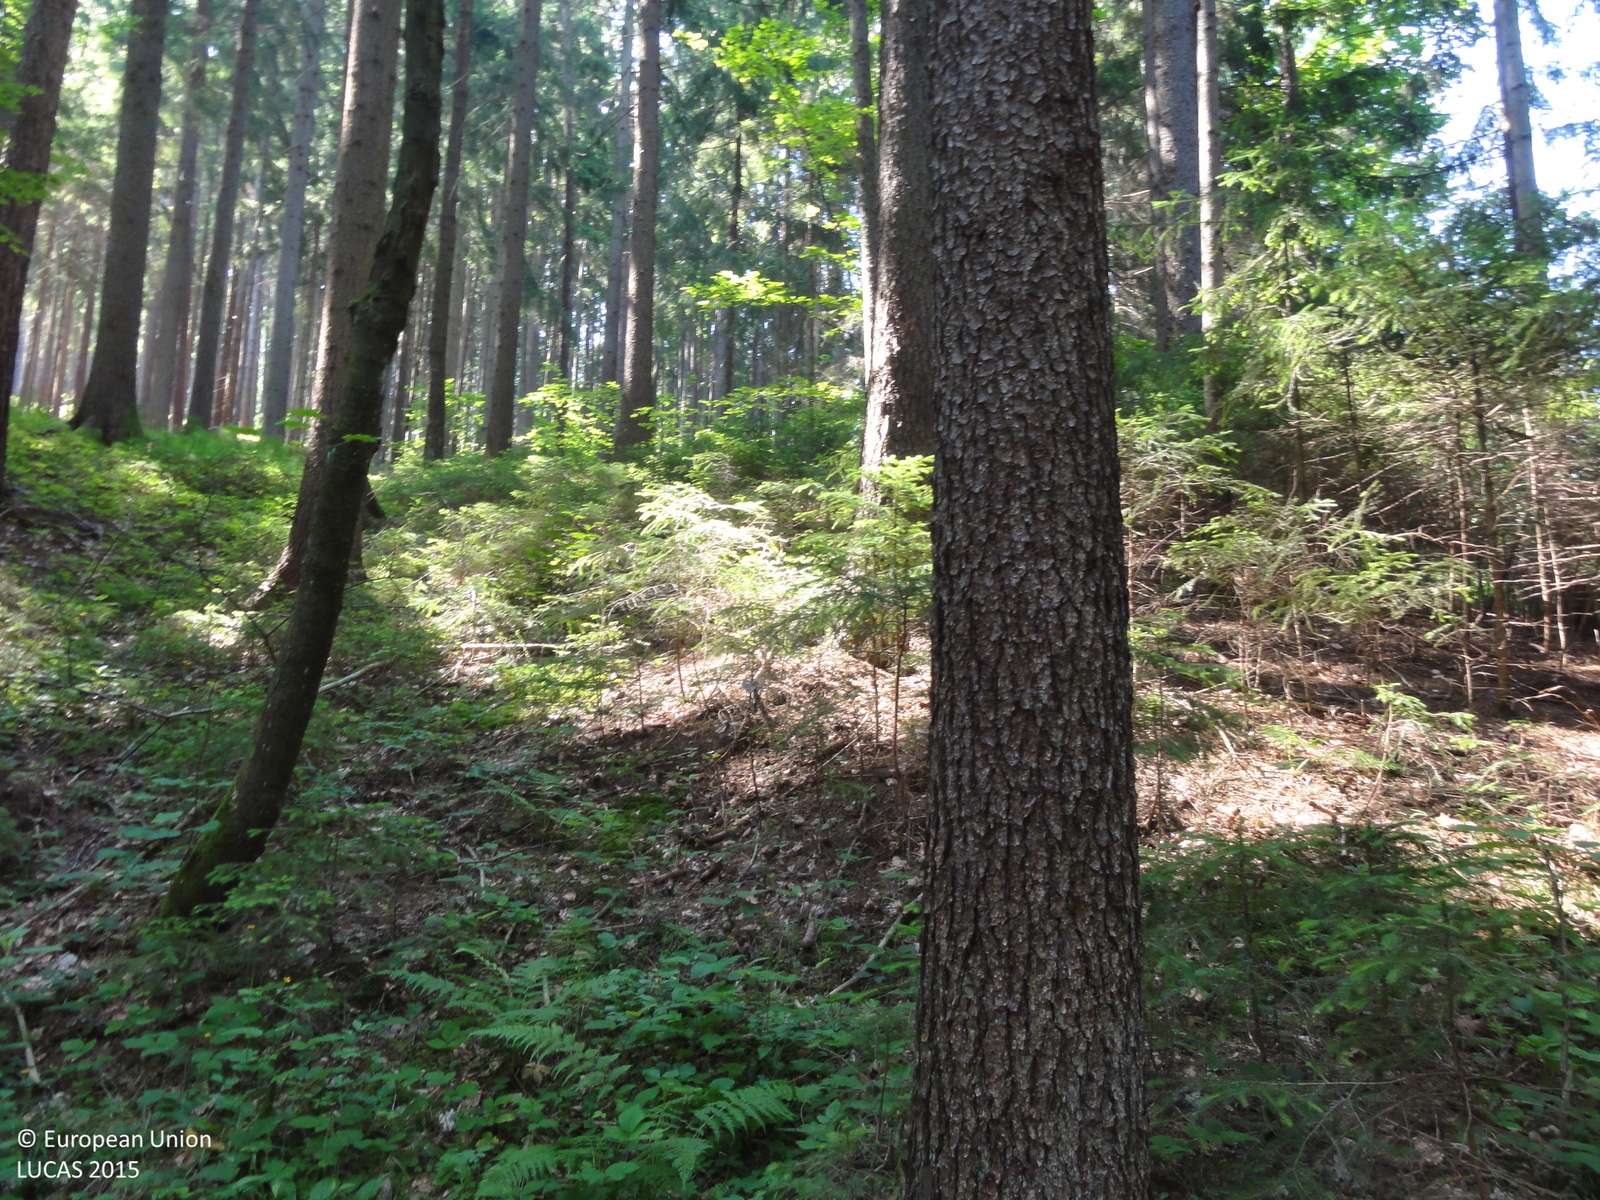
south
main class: Woodland
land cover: Spruce dominated coniferous woodland
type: hemiboreal forest and nemoral coniferous forest and mixed broadleaved-coniferous forest
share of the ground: > 75 %
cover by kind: coniferous forest trees 95 %, broadleaved forest trees 5 %
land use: Forestry
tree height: > 5 m
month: June
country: SI
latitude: 46.5271
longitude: 14.9127
